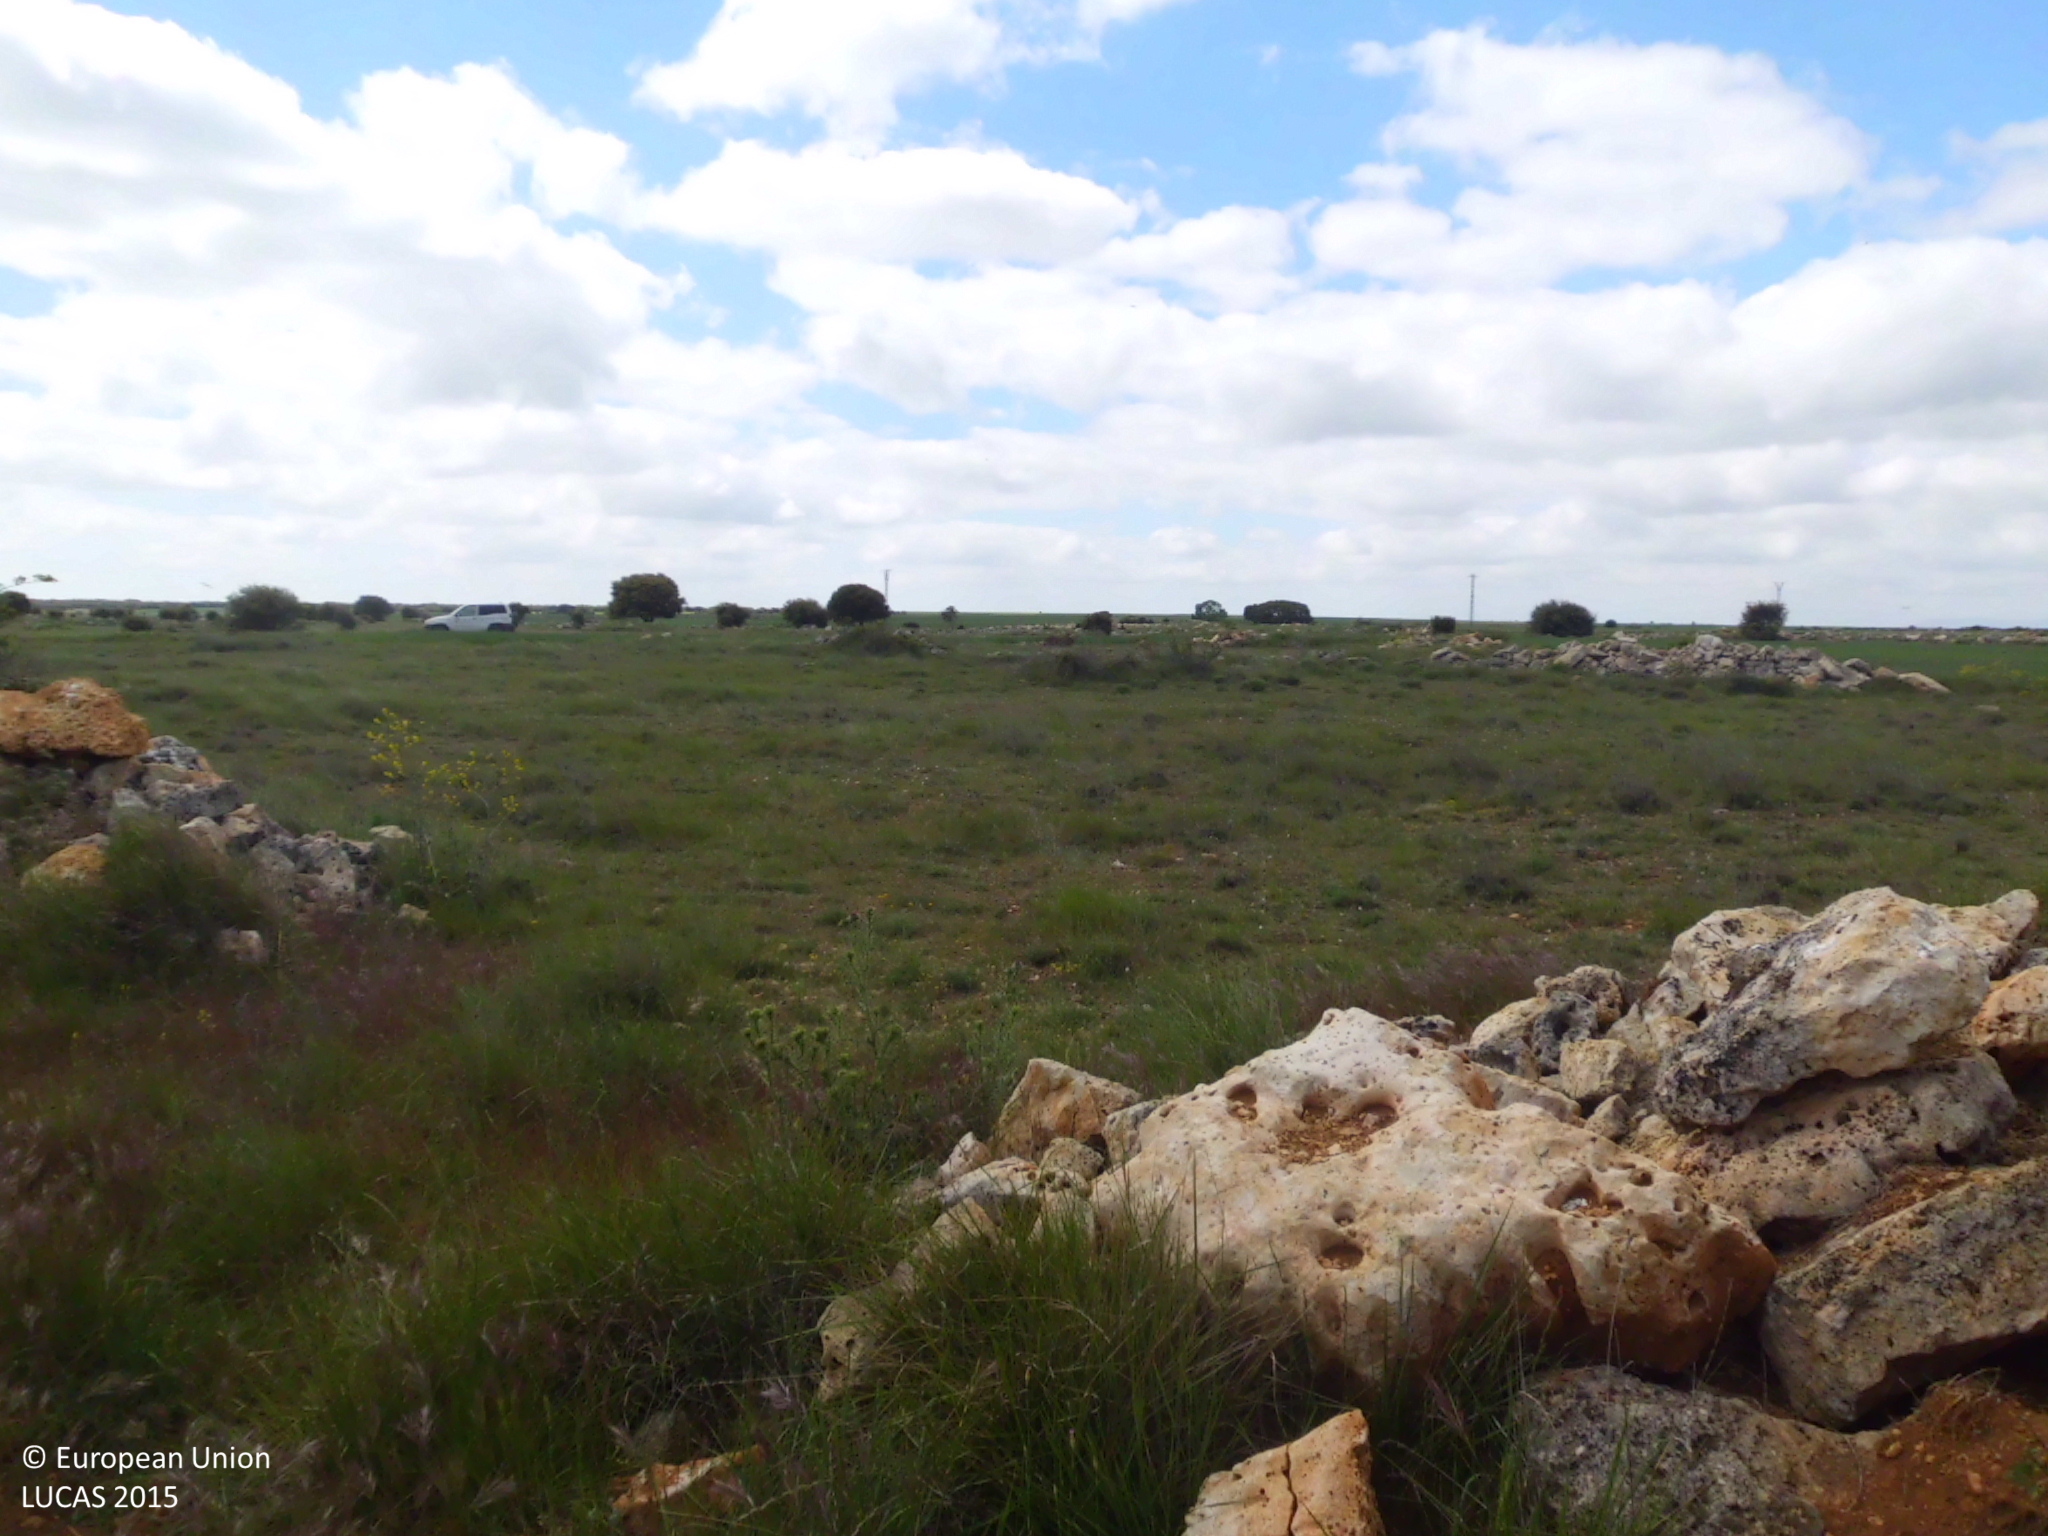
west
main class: Cropland
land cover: Common wheat
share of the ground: > 75 %
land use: Agriculture (excluding fallow land and kitchen gardens)
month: May
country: ES
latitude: 42.4112
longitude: -3.9789
